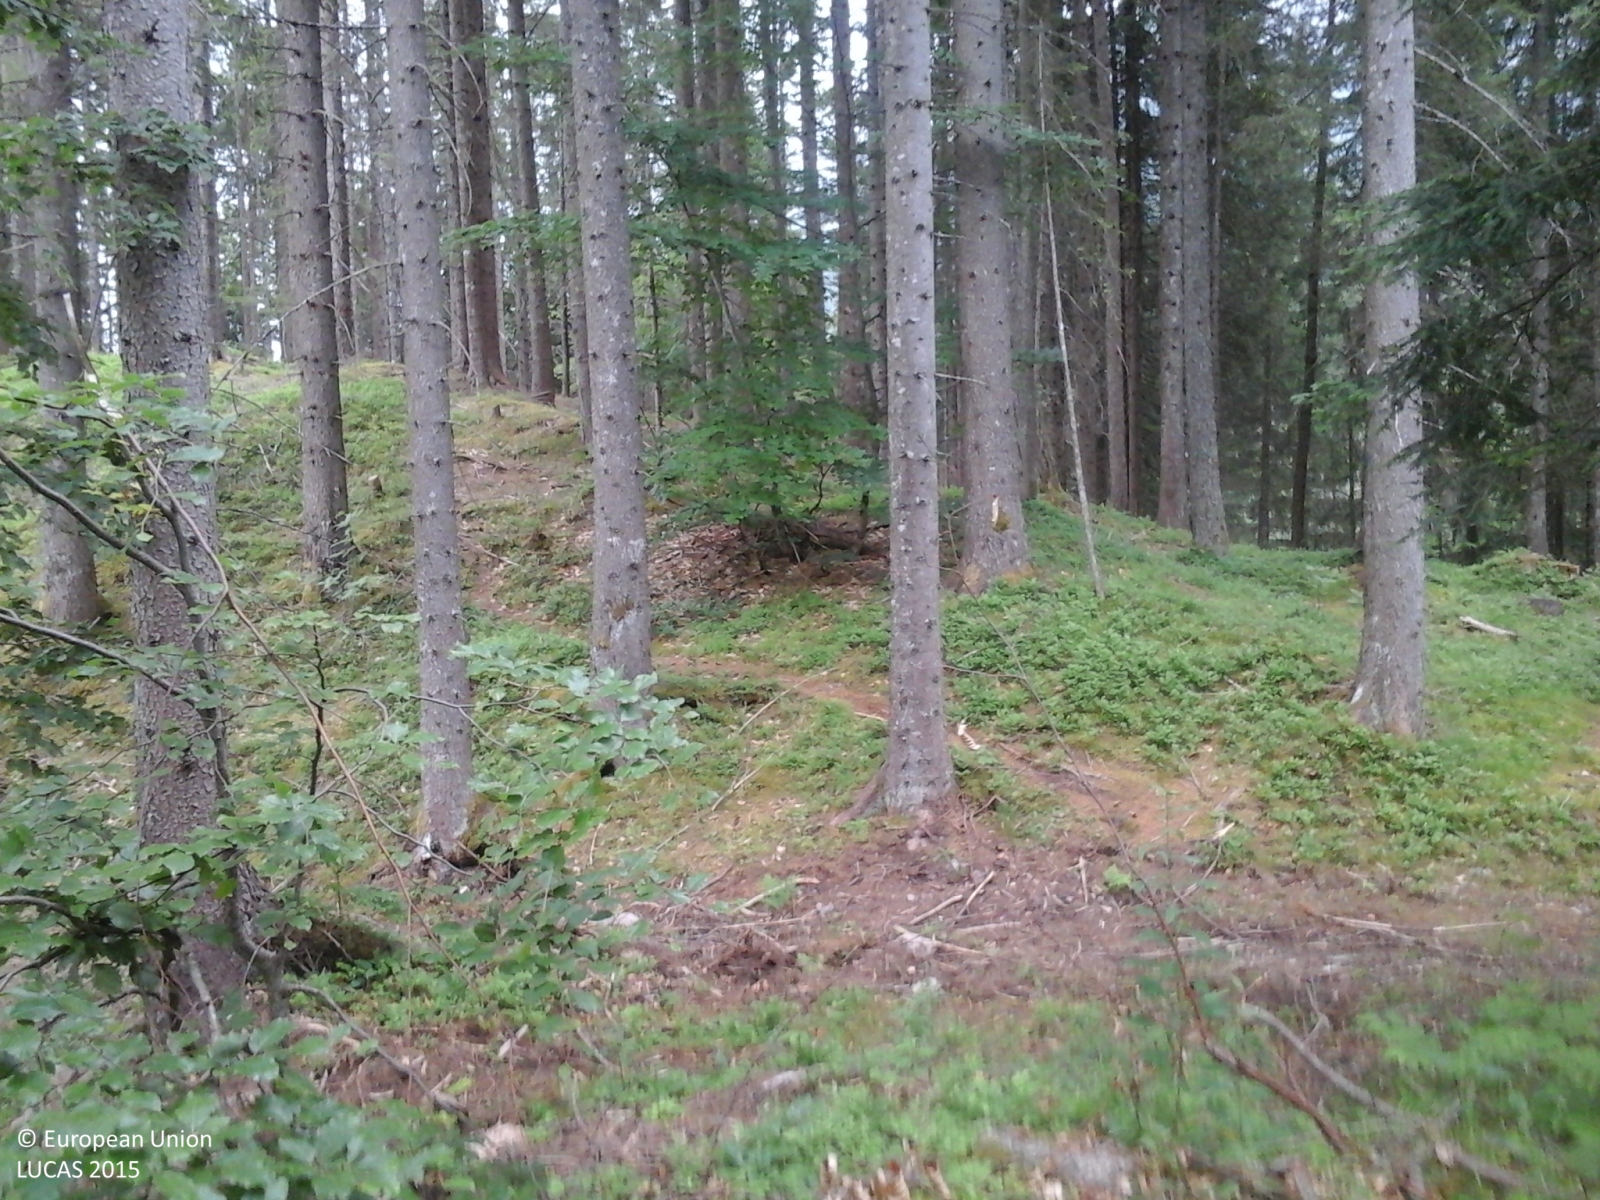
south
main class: Woodland
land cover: Spruce dominated coniferous woodland
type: alpine coniferous forest
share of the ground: > 75 %
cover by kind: coniferous forest trees 80 %, broadleaved forest trees 10 %, shrubs 10 %
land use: Forestry
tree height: > 5 m
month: June
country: IT
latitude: 46.6291
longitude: 12.4660
